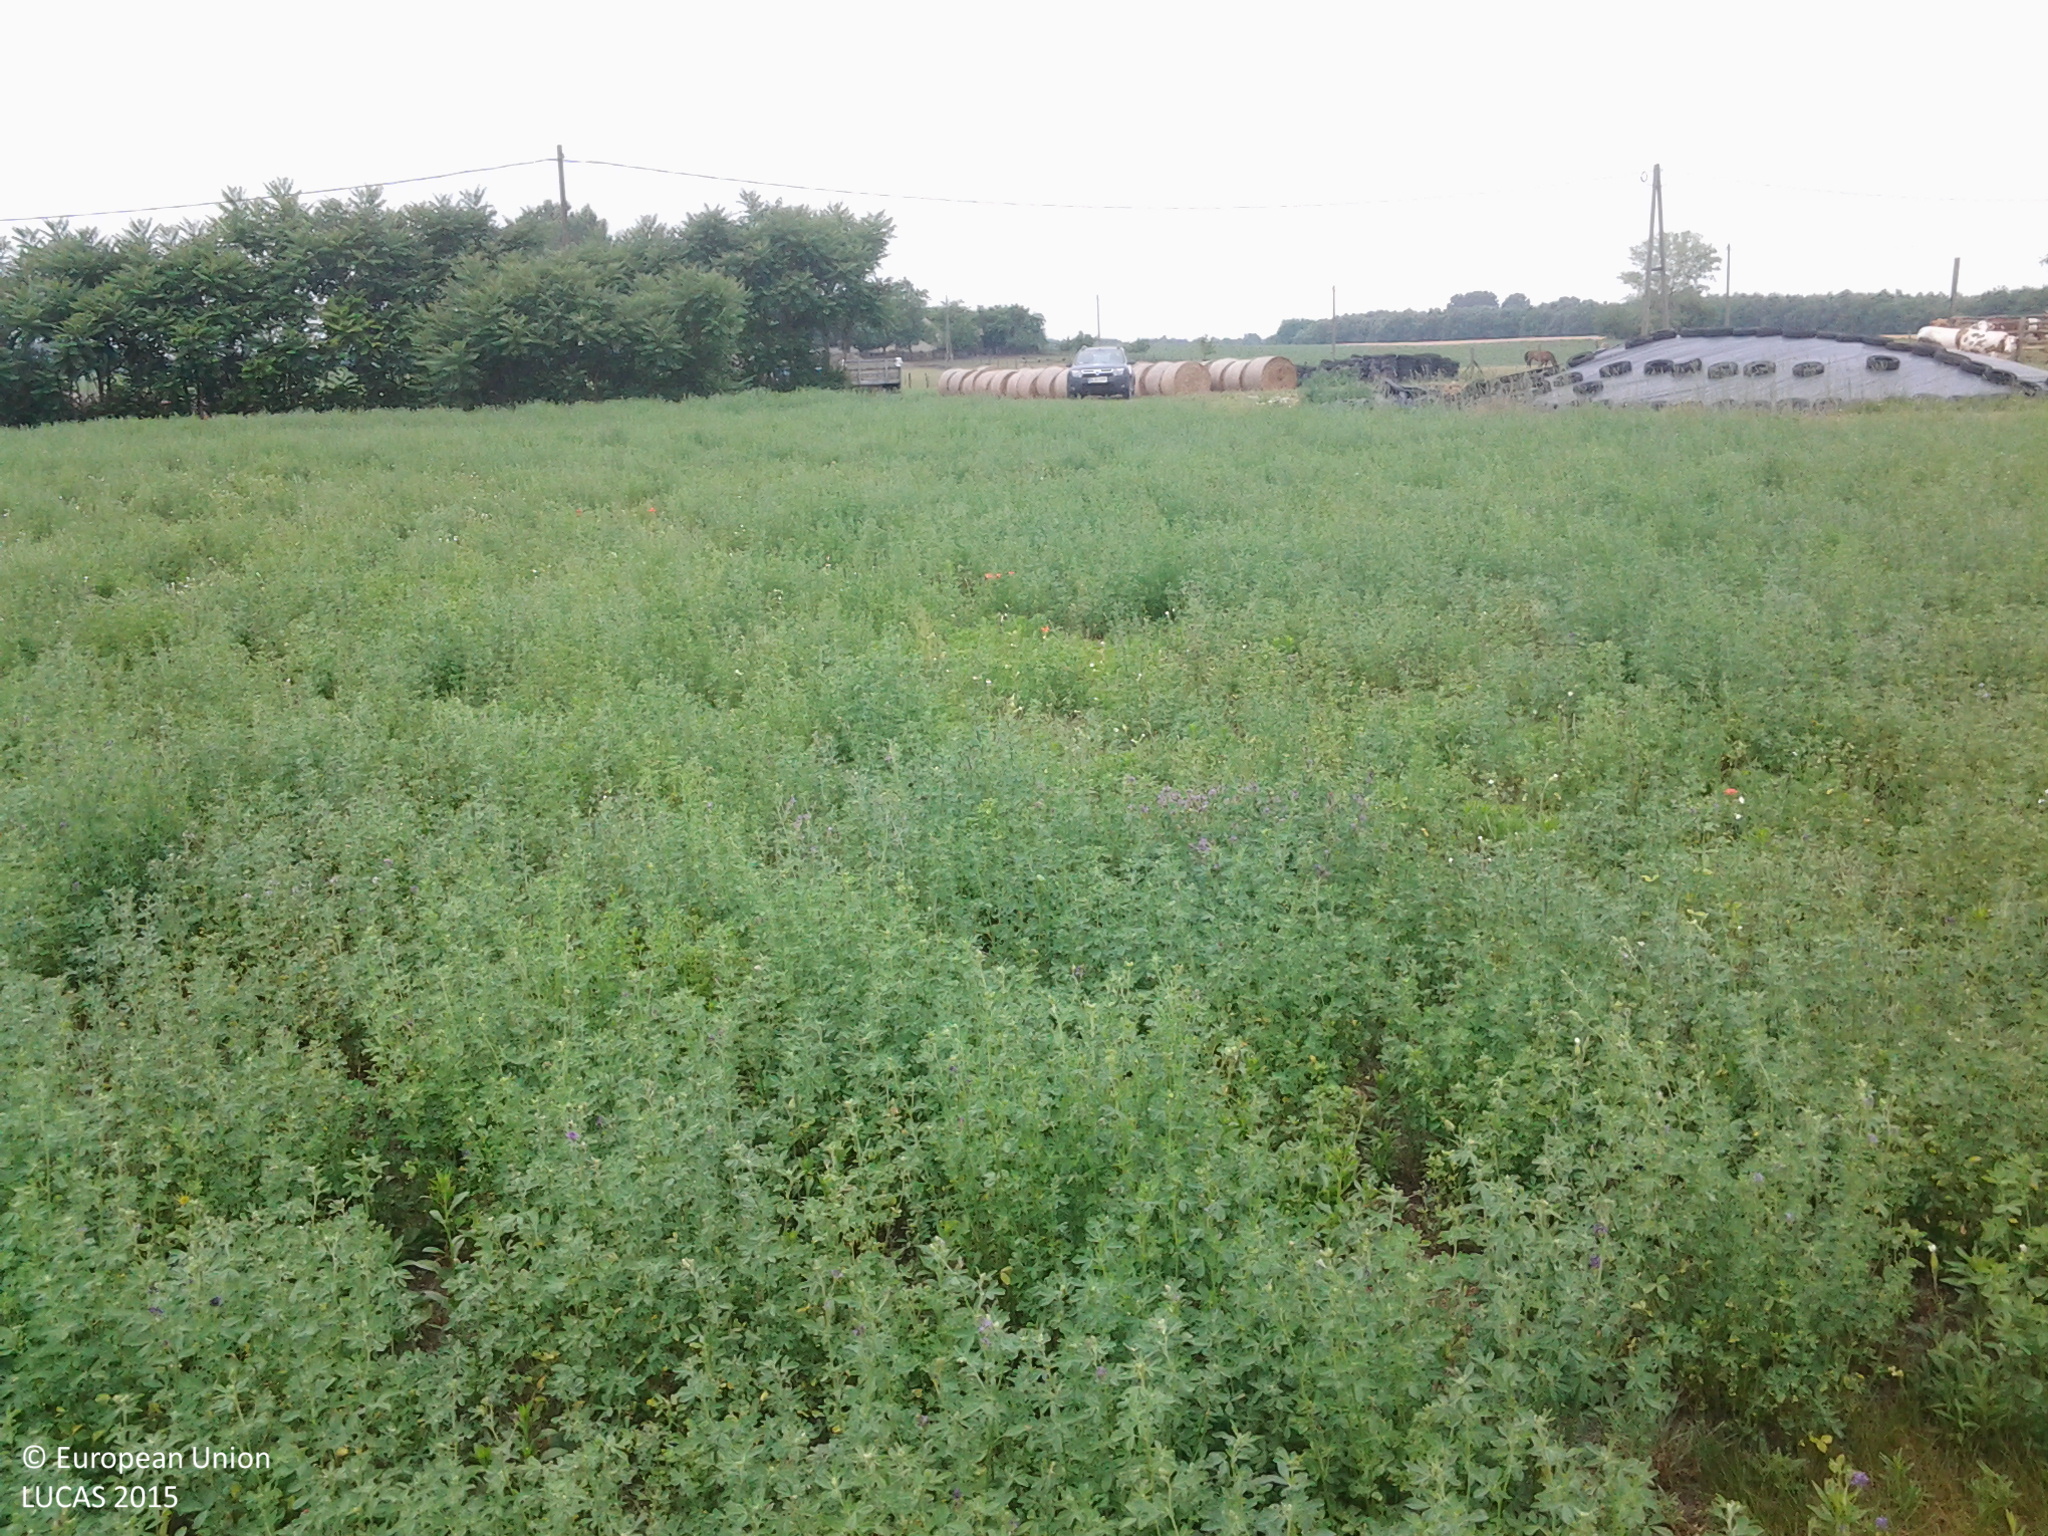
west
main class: Cropland
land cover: Lucerne
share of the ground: > 75 %
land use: Agriculture (excluding fallow land and kitchen gardens)
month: June
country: HU
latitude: 47.0008
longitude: 19.6608
